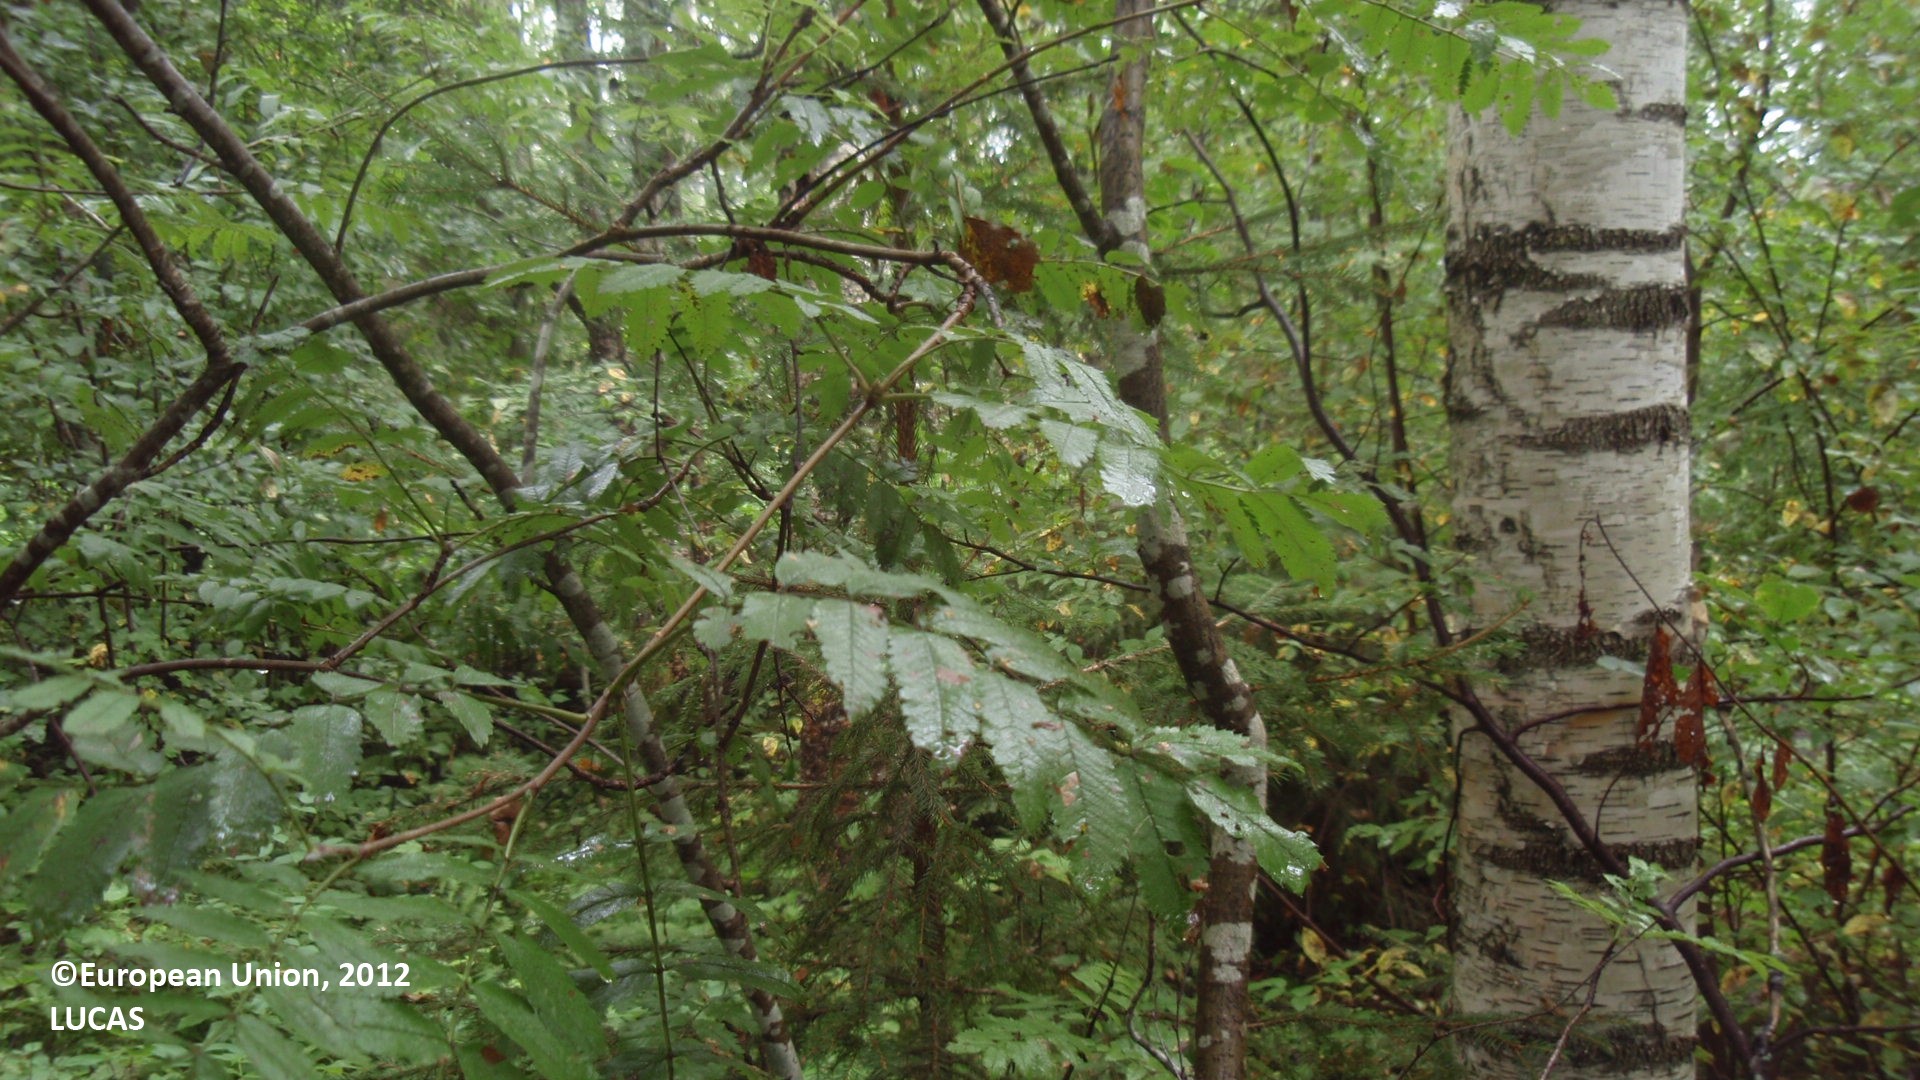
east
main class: Woodland
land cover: Broadleaved woodland
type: non-riverine alder, birch or aspen forest
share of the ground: 50 - 75 %
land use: Forestry
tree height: > 5 m
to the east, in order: Broadleaved woodland; Shrubland with sparse tree cover; Broadleaved woodland
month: August
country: FI
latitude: 61.2331
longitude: 27.0999
